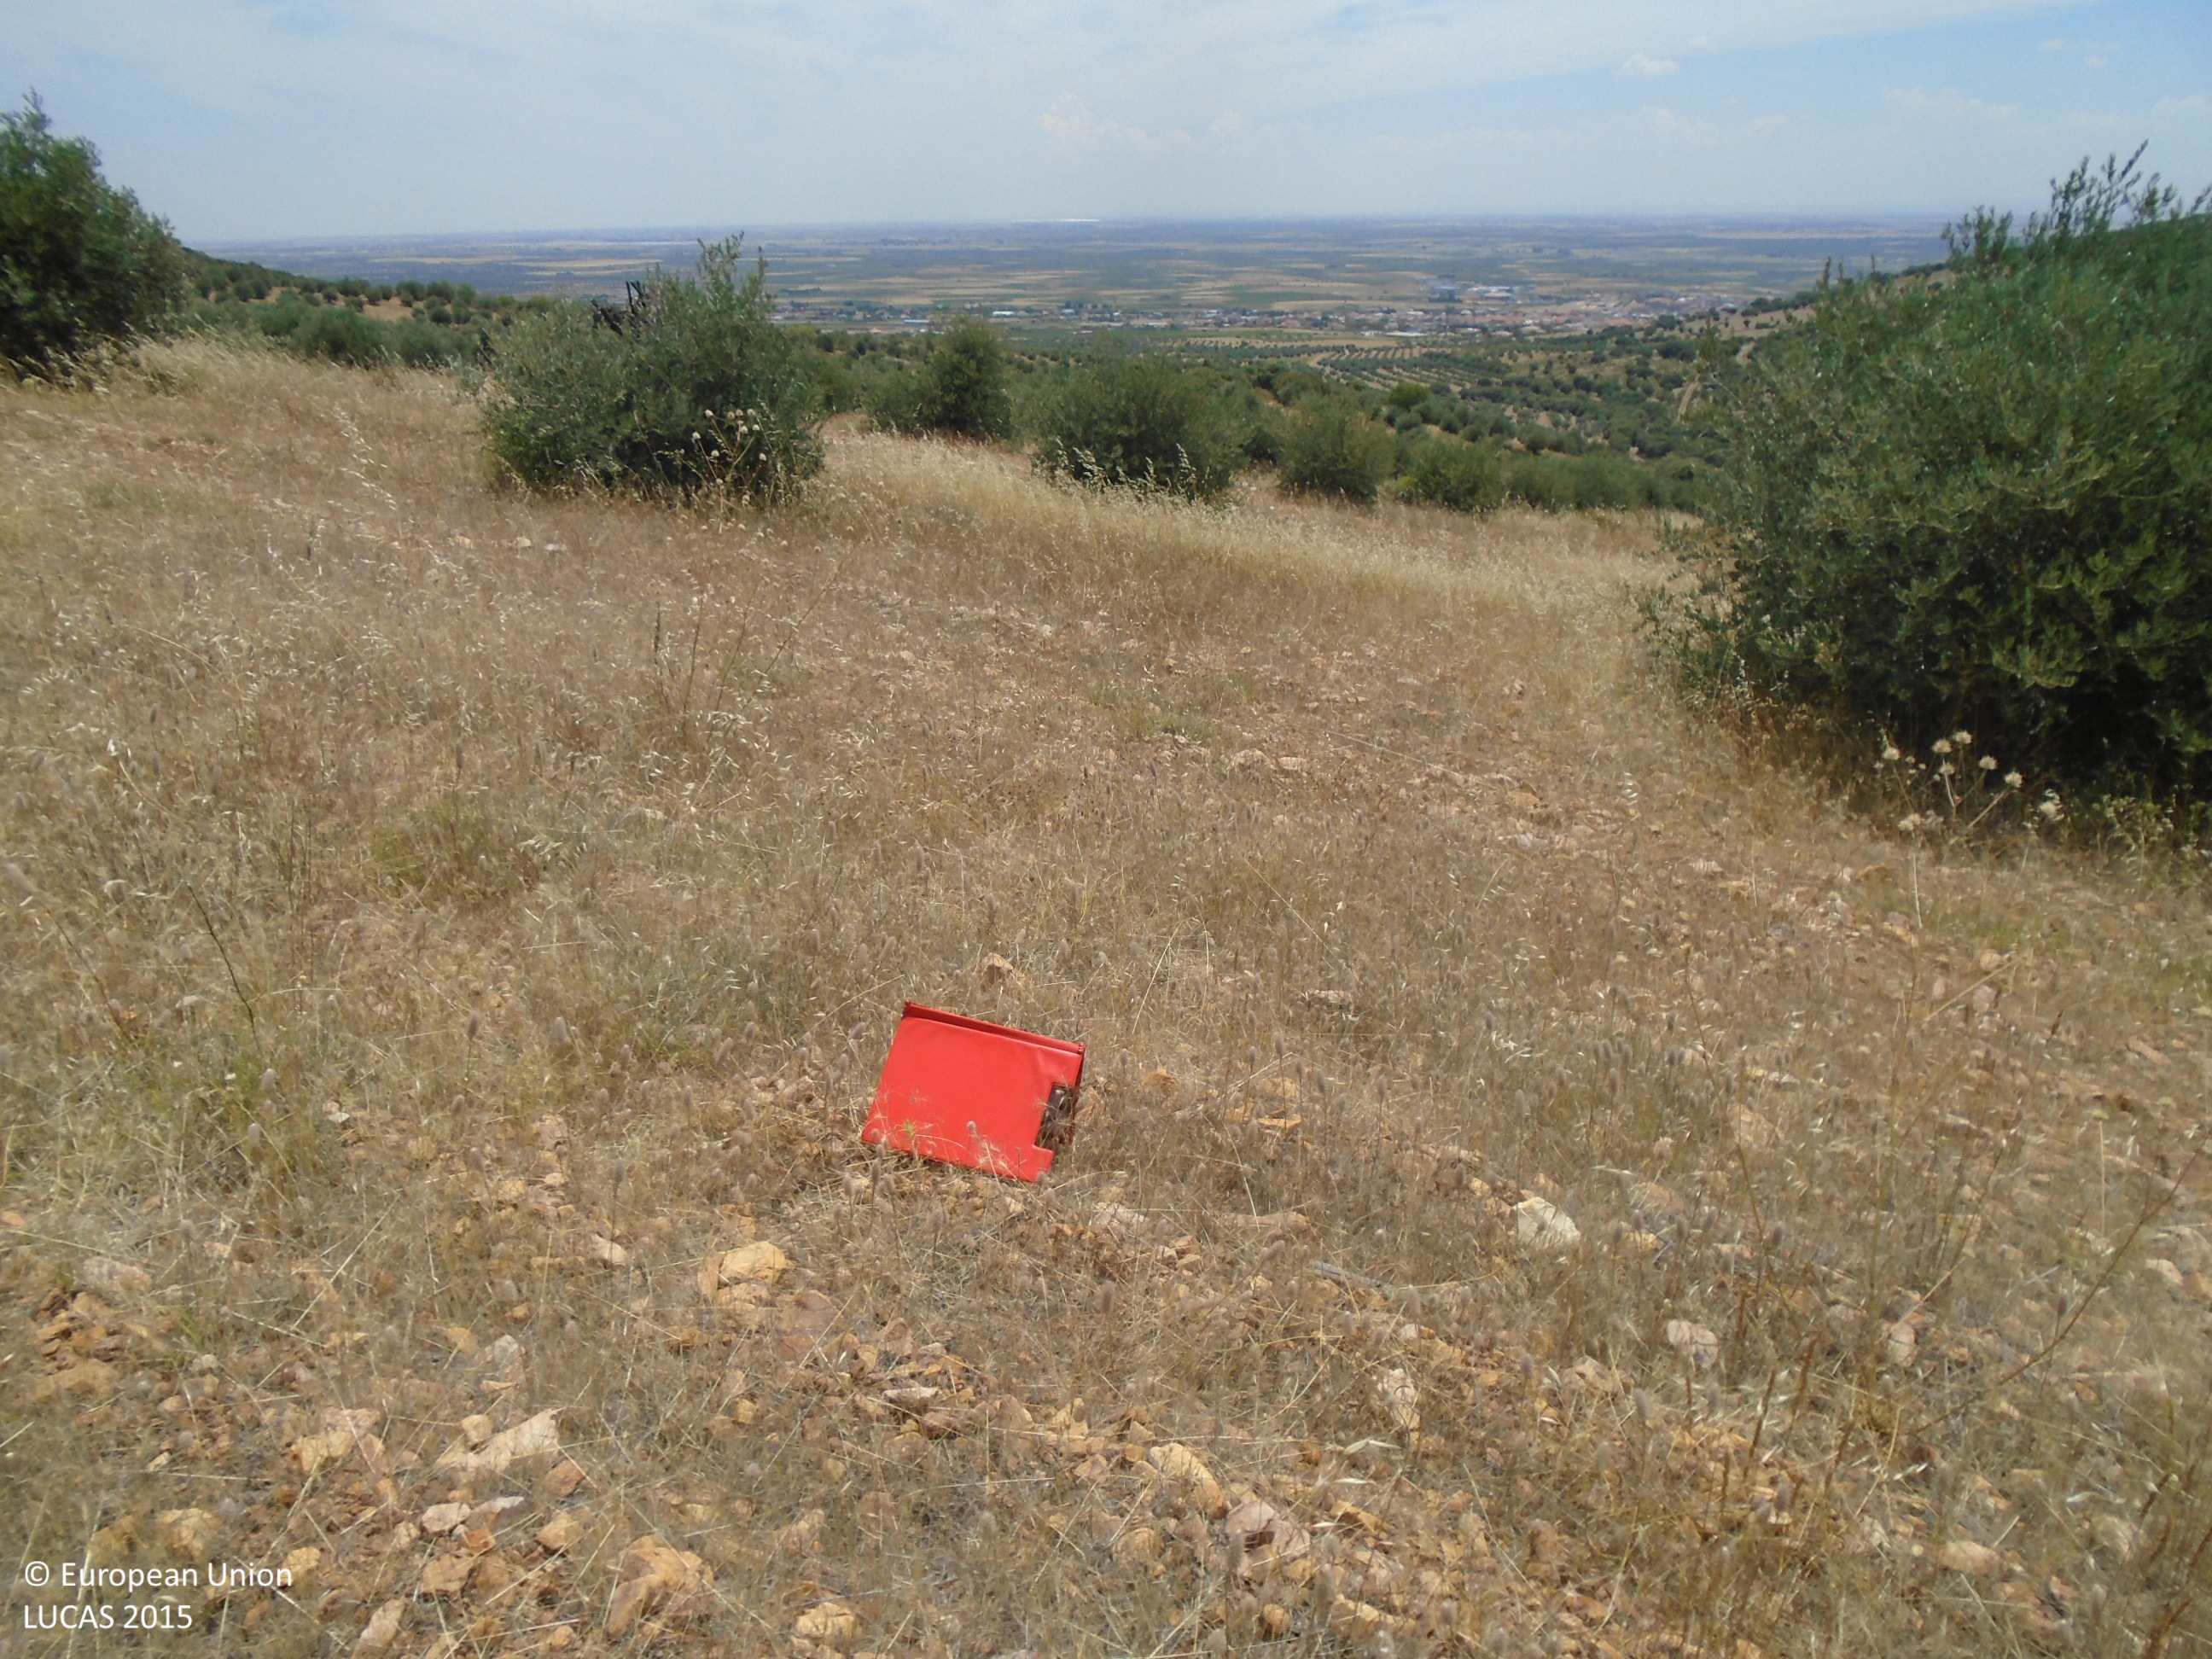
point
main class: Cropland
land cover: Olive groves
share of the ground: 10 - 25 %
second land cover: Spontaneously vegetated surfaces
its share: > 75 %
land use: Agriculture (excluding fallow land and kitchen gardens)
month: June
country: ES
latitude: 39.2374
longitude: -3.6335
